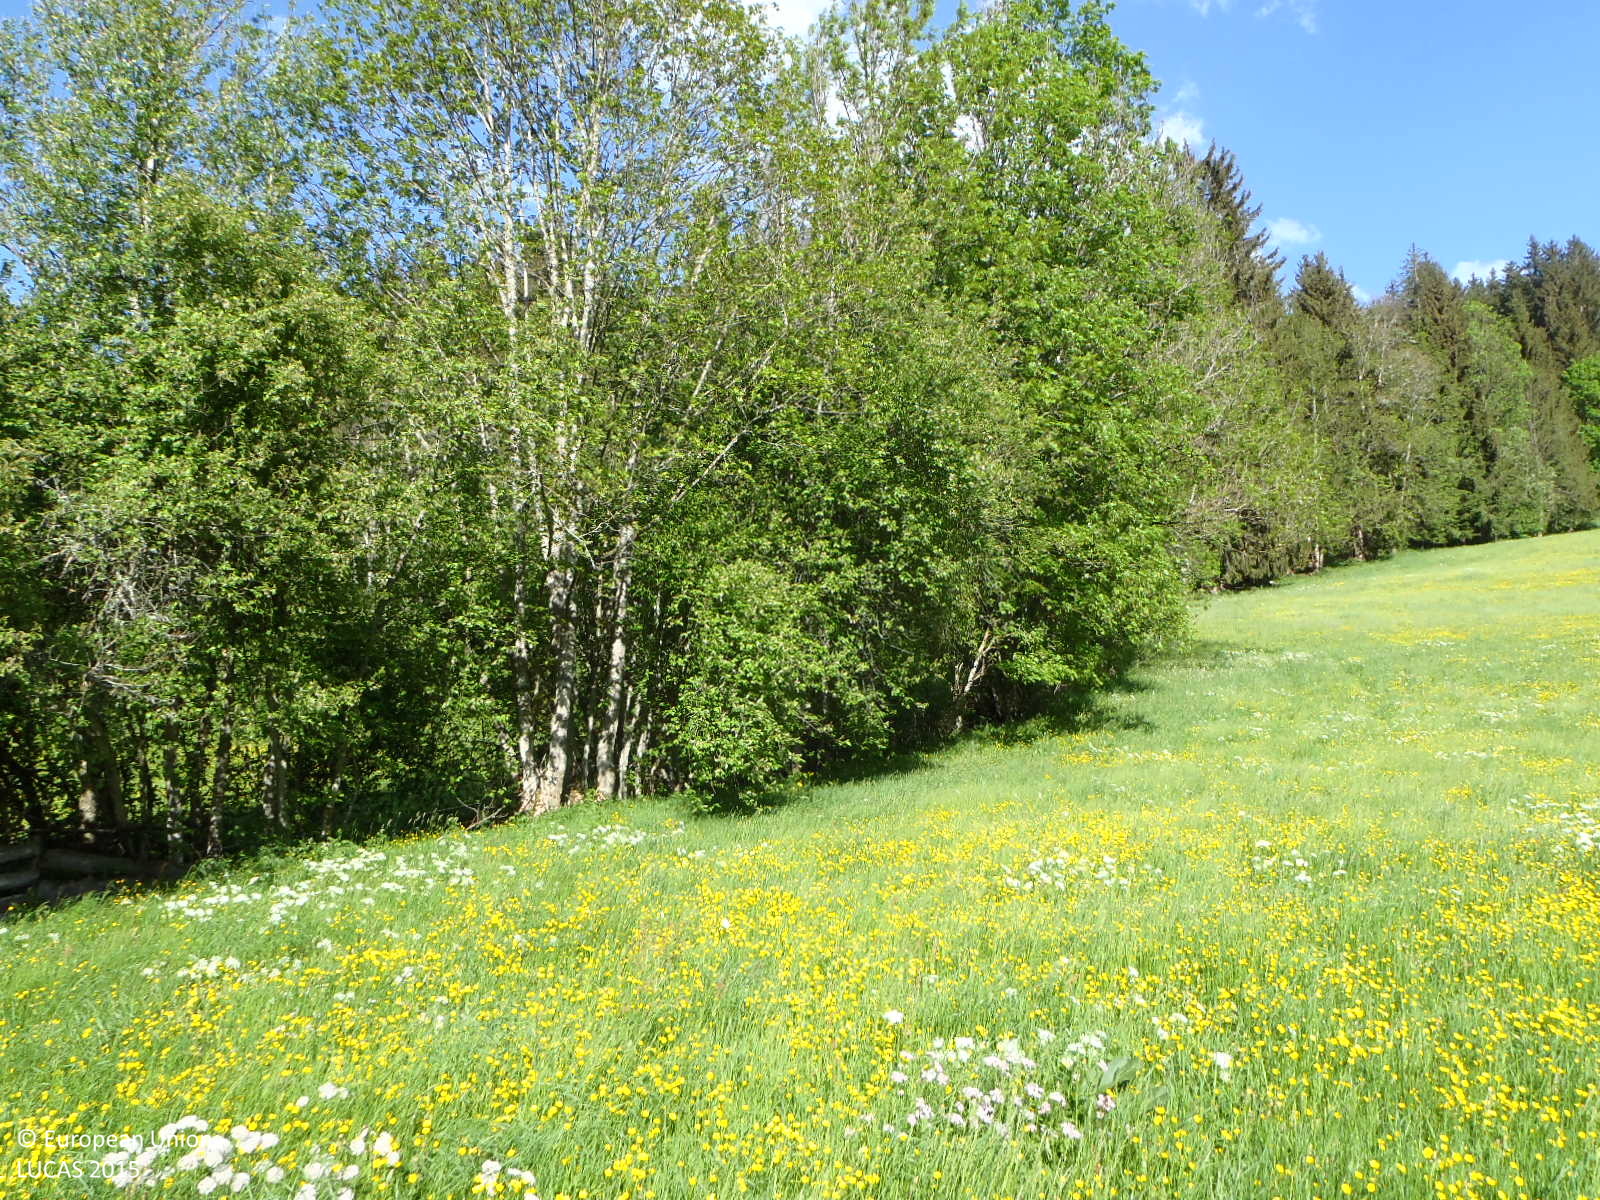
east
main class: Grassland
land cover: Grassland without tree/shrub cover
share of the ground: > 75 %
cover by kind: herbaceous plants 100 %
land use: Agriculture (excluding fallow land and kitchen gardens)
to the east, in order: Grassland without tree/shrub cover; Fences; Broadleaved woodland; Rivers and streams; Grassland without tree/shrub cover; Rivers and streams; Lines of trees; Grassland without tree/shrub cover; Broadleaved woodland; Fences; Spruce dominated coniferous woodland; Fences; Spruce dominated coniferous woodland; Rivers and streams; Spruce dominated coniferous woodland; Rivers and streams; Spruce dominated coniferous woodland; Grassland with sparse tree/shrub cover; Tracks; Grassland without tree/shrub cover; Tracks; Ditches and canals; Spruce dominated coniferous woodland
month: May
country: AT
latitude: 47.3597
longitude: 13.4274
